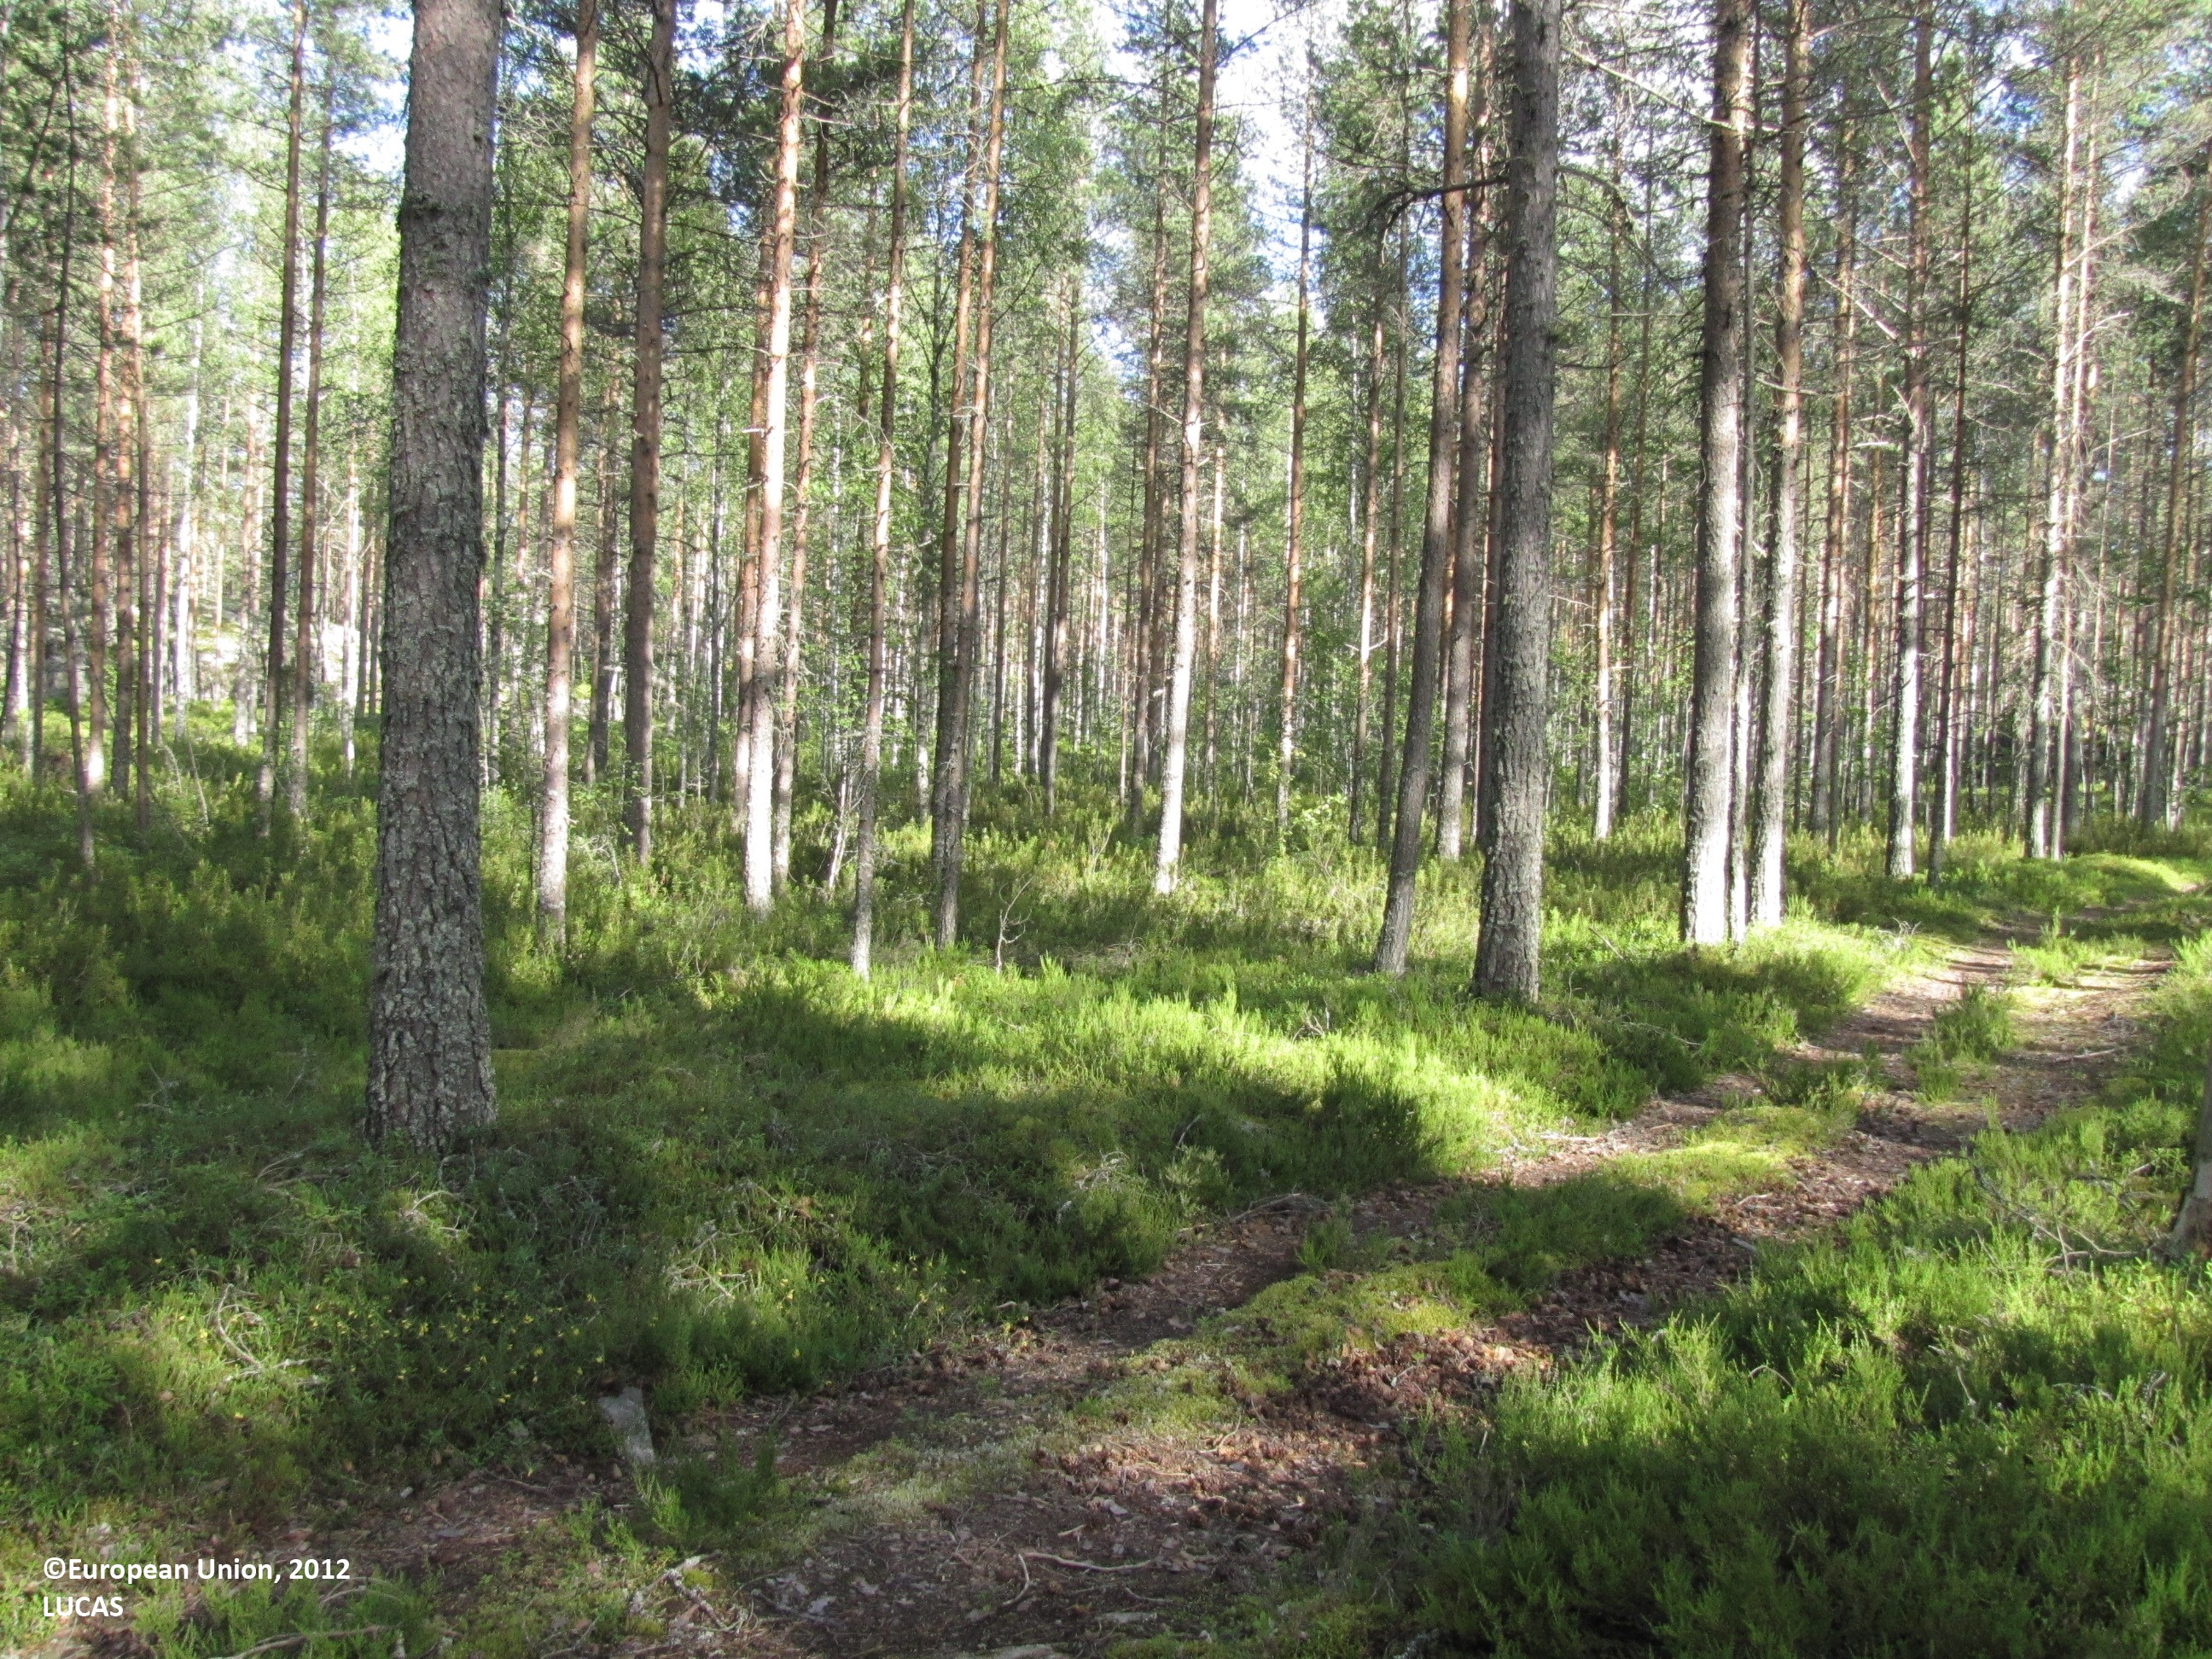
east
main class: Woodland
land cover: Pine dominated coniferous woodland
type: boreal forest
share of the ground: > 75 %
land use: Forestry
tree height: > 5 m
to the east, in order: Pine dominated coniferous woodland
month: July
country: FI
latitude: 62.3625
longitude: 23.1486
